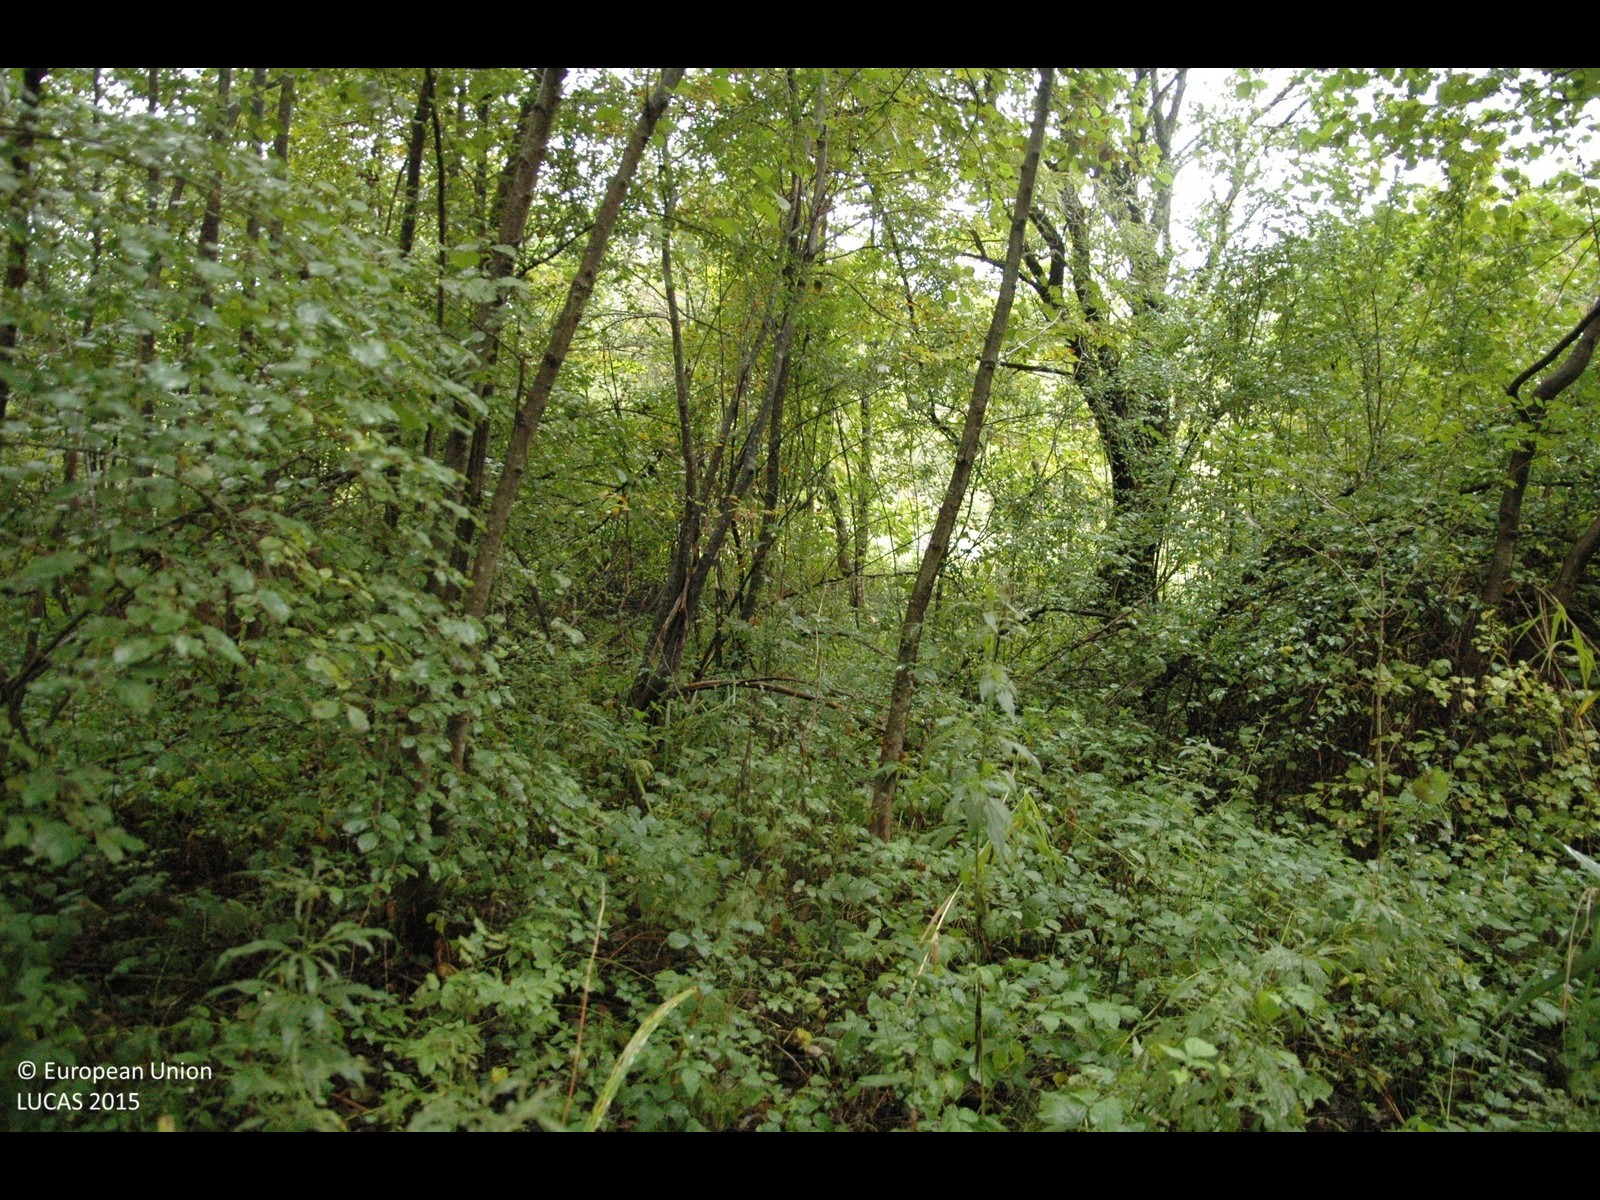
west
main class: Woodland
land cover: Broadleaved woodland
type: mesophytic deciduous forest
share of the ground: > 75 %
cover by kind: broadleaved forest trees 100 %
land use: Semi-natural and natural areas not in use
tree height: > 5 m
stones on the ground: < 10 %
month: October
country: HR
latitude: 45.1559
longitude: 15.2740
